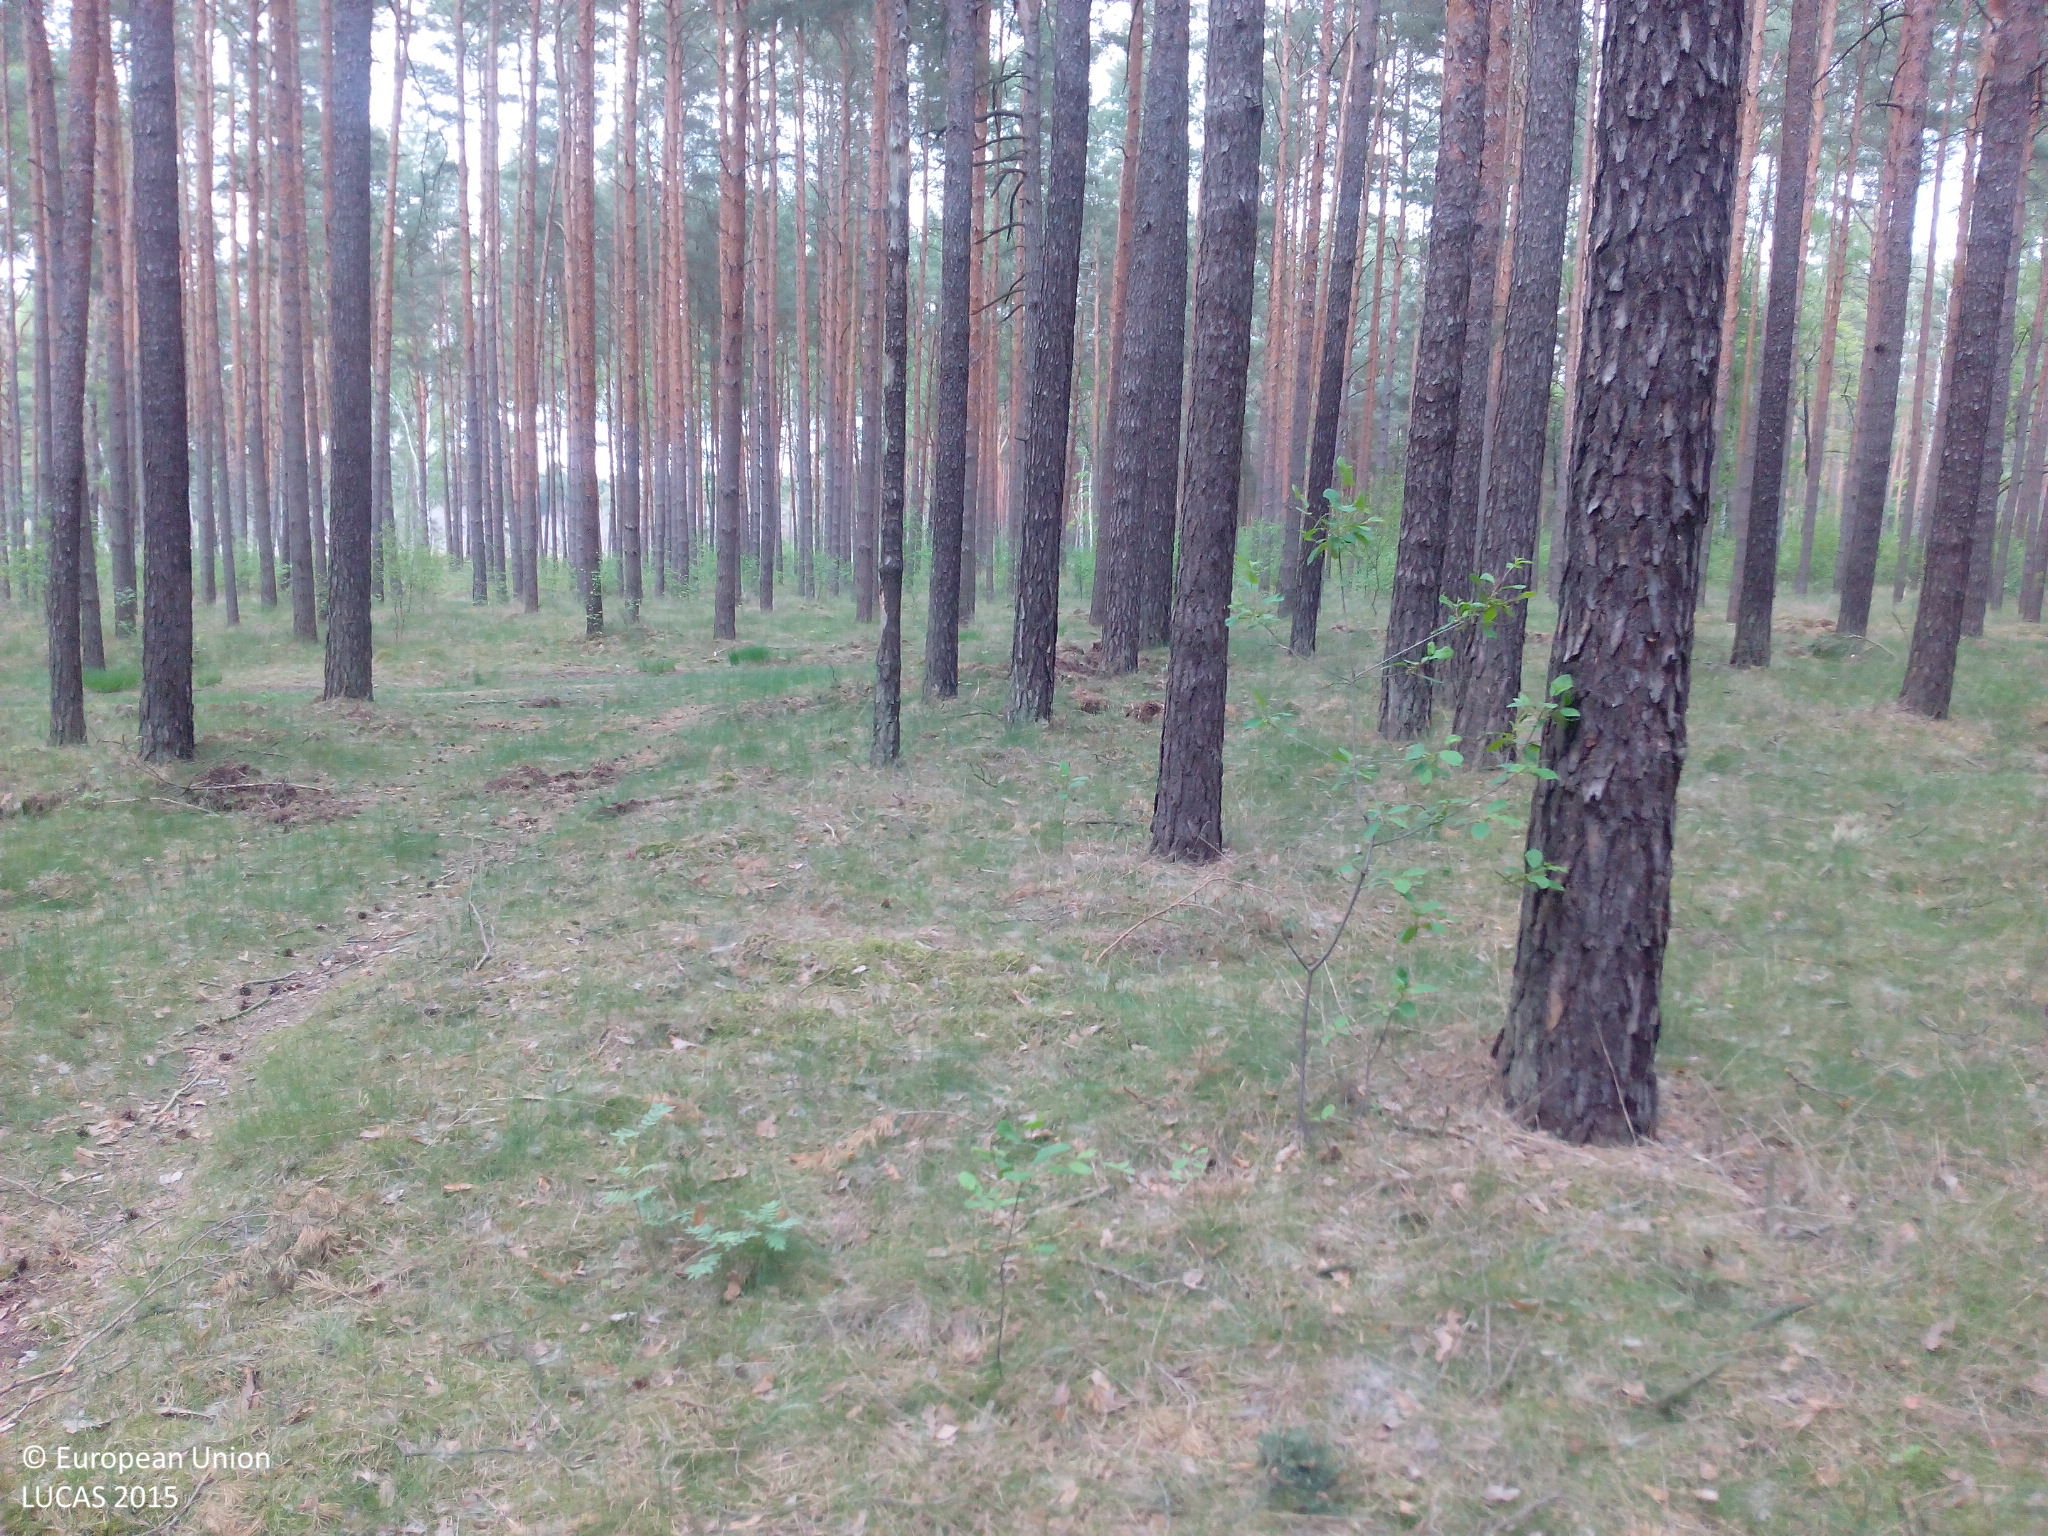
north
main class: Woodland
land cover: Pine dominated coniferous woodland
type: hemiboreal forest and nemoral coniferous forest and mixed broadleaved-coniferous forest
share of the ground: > 75 %
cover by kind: coniferous forest trees 80 %, herbaceous plants 10 %, lichens and mosses 5 %, unconsolidated bare surface 5 %
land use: Forestry
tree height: > 5 m
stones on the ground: < 10 %
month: May
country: DE
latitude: 52.1373
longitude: 13.1705
